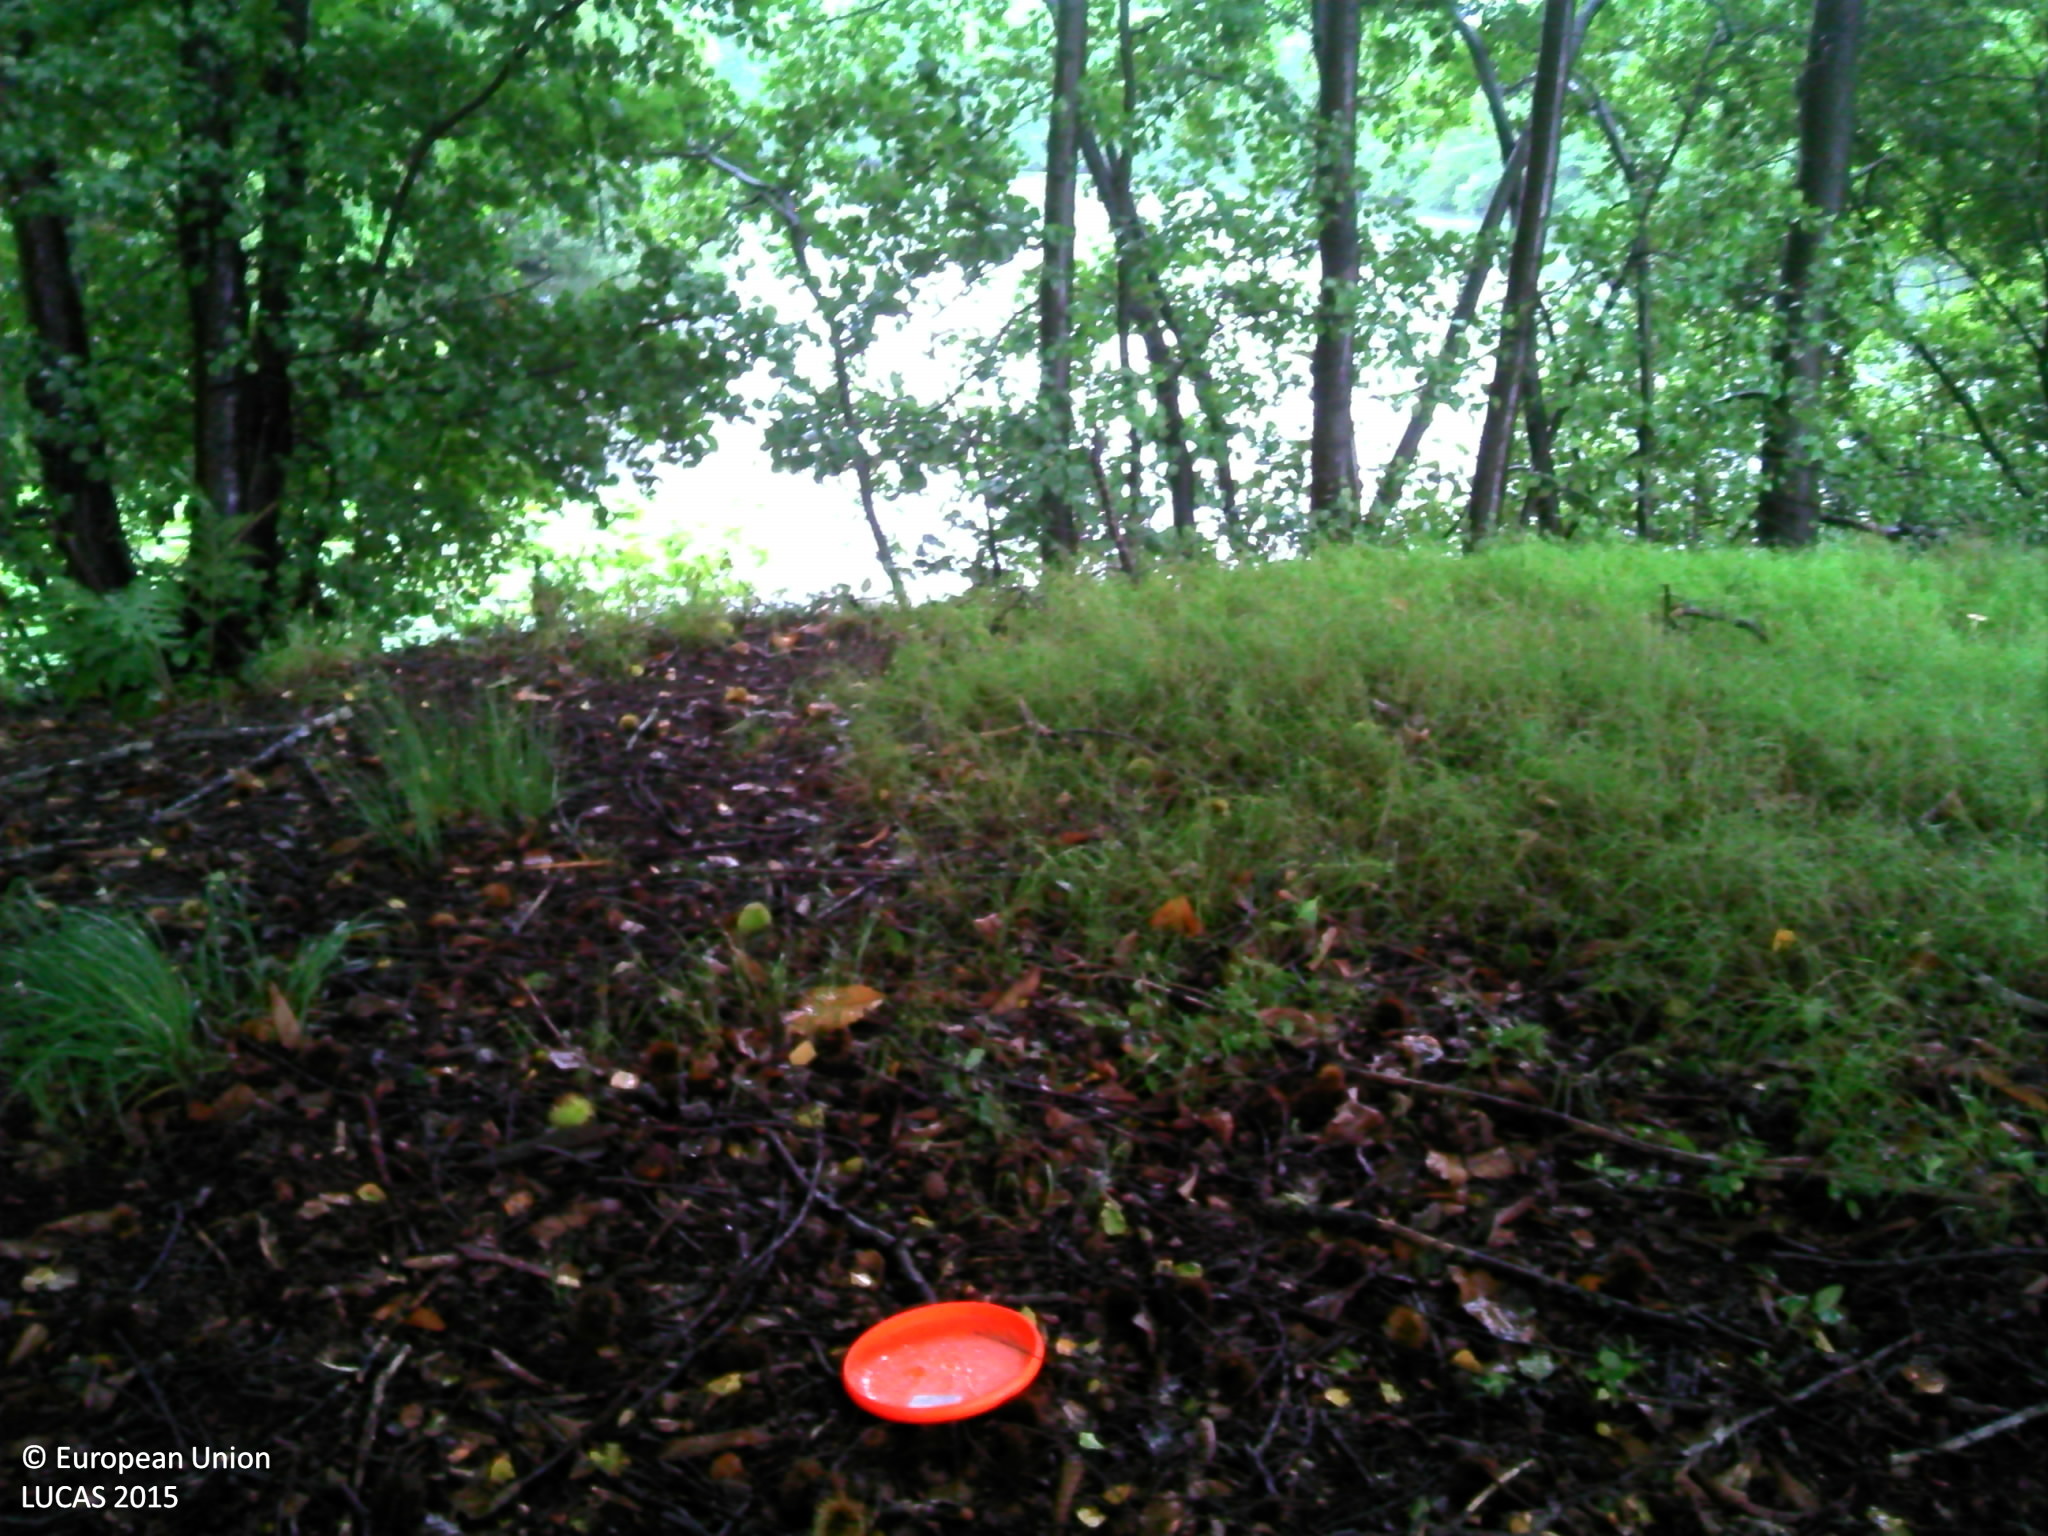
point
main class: Woodland
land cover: Broadleaved woodland
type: floodplain forest
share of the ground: > 75 %
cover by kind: broadleaved forest trees 80 %, herbaceous plants 20 %
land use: Forestry
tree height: > 5 m
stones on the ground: < 10 %
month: September
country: BE
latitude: 51.3416
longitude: 4.7279
